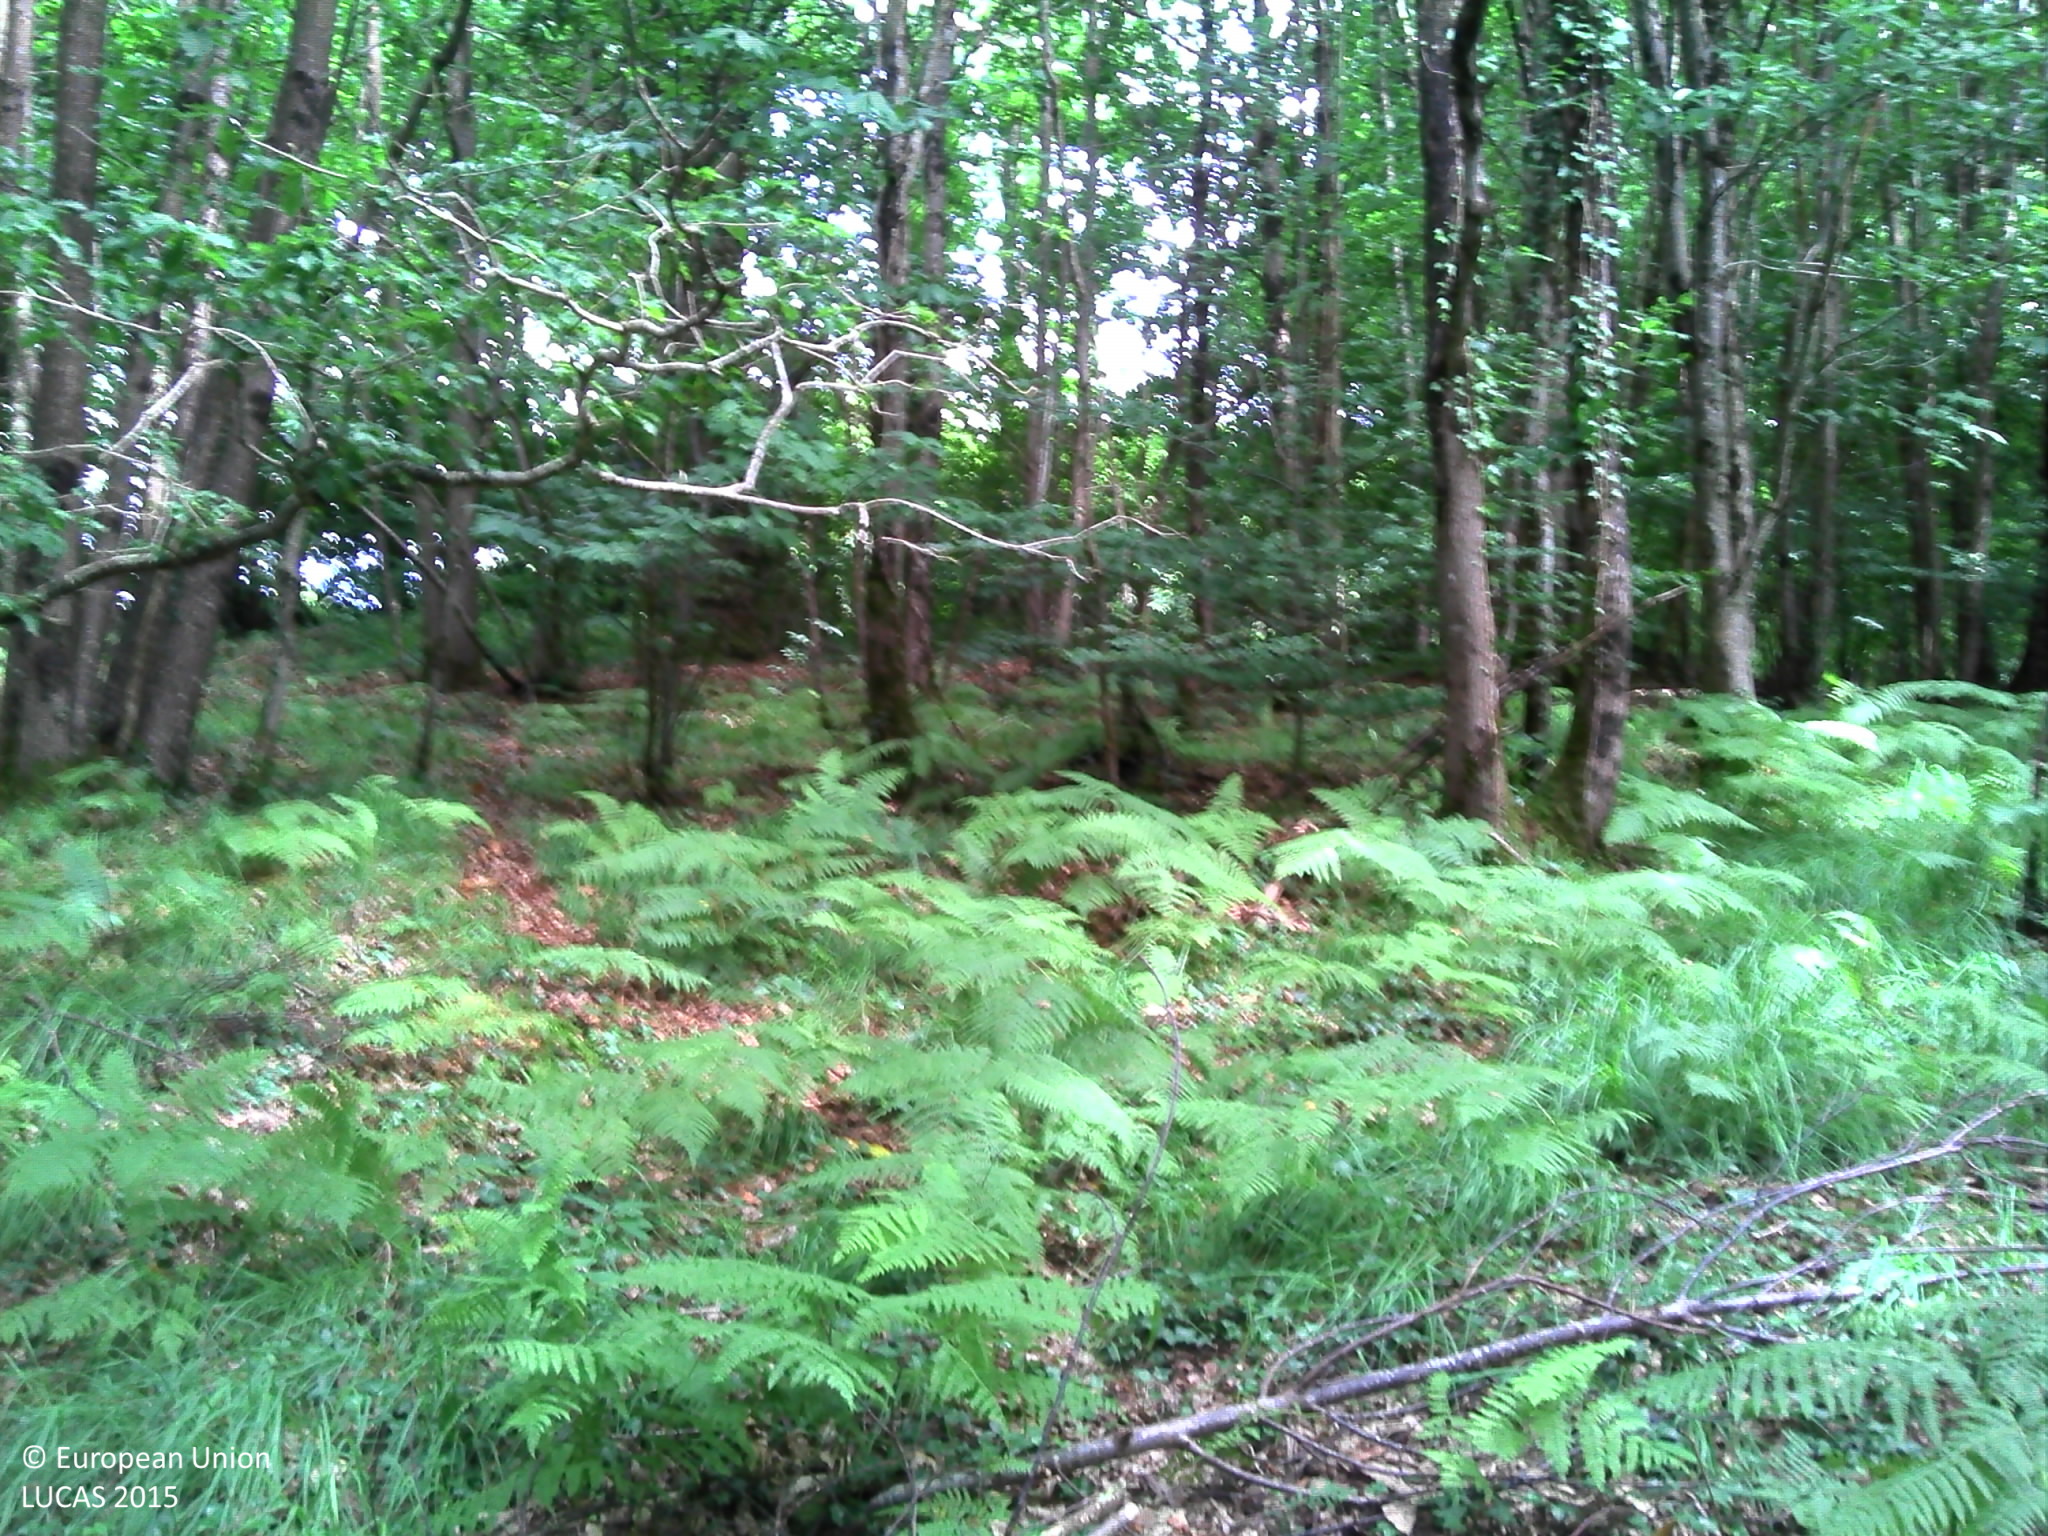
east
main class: Woodland
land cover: Broadleaved woodland
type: mesophytic deciduous forest
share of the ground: > 75 %
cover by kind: broadleaved forest trees 100 %
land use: Forestry
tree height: > 5 m
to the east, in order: Broadleaved woodland; Fences; Tracks; Fences; Grassland without tree/shrub cover; Fences; Broadleaved woodland
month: August
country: FR
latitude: 48.7016
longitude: -1.2268
